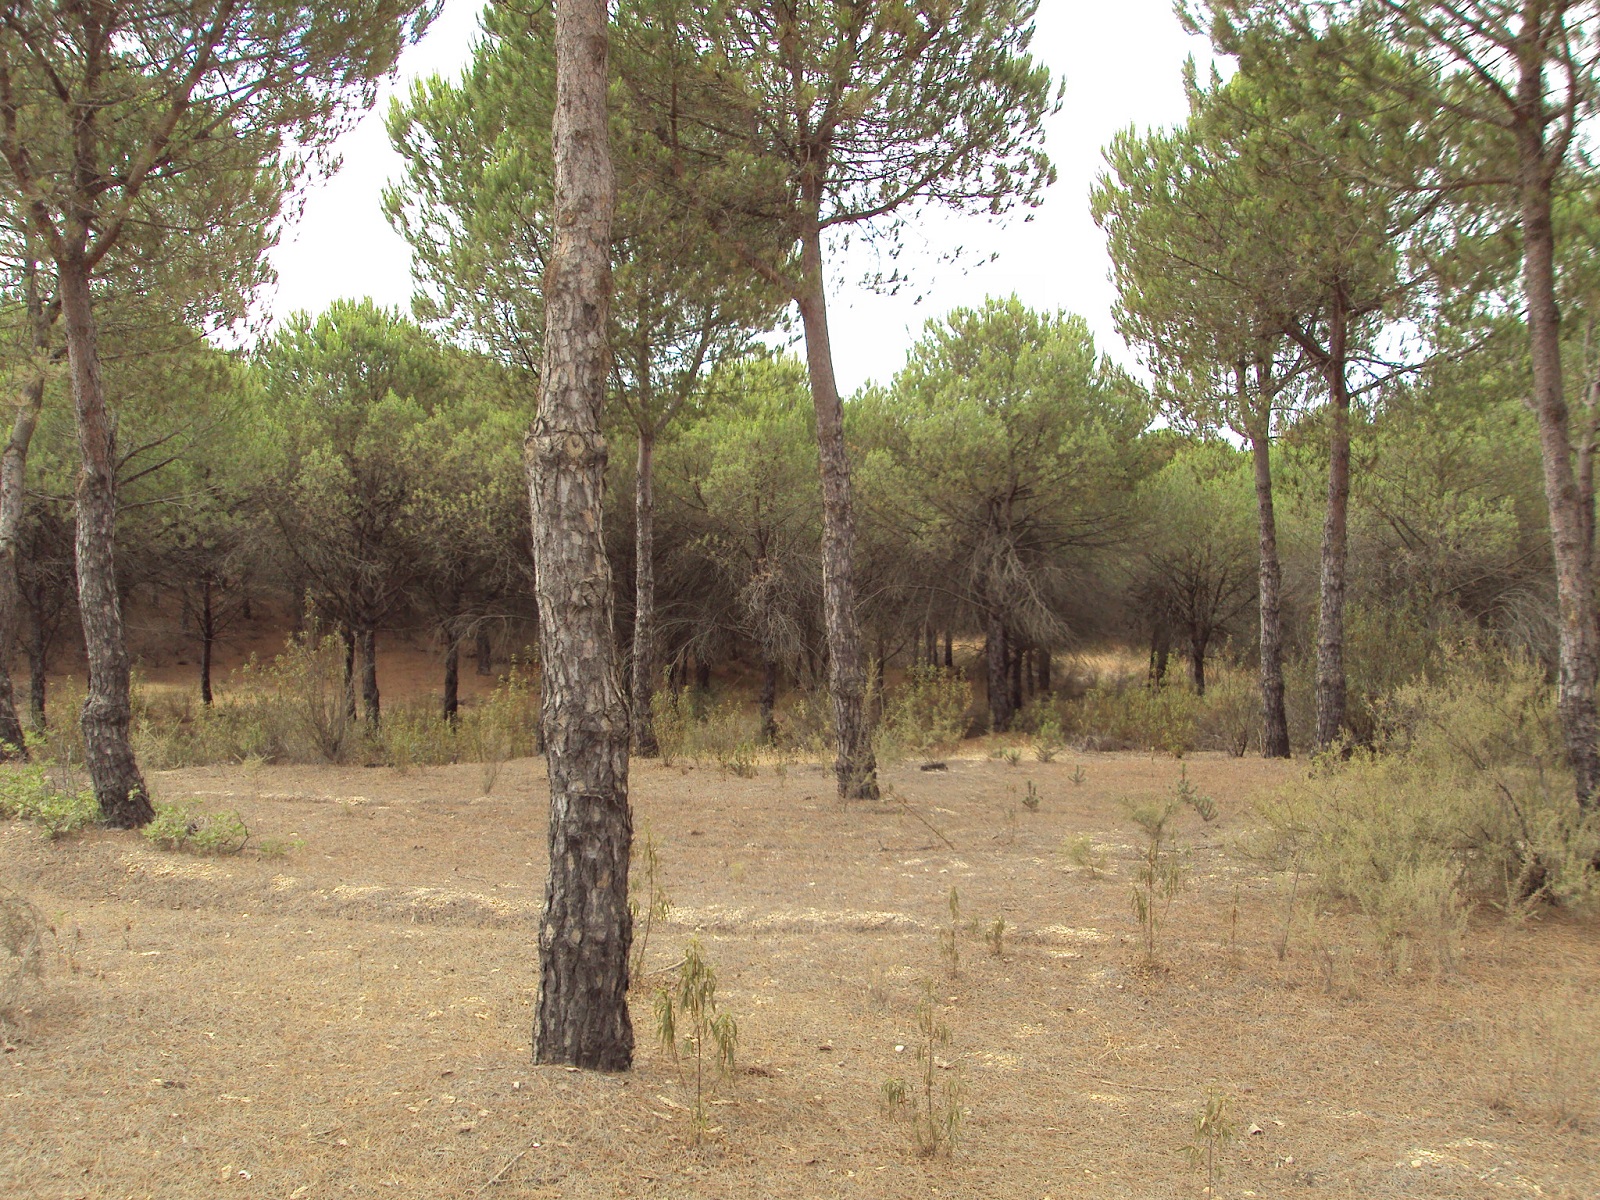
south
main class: Woodland
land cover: Pine dominated coniferous woodland
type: coniferous forest of the mediterranean region
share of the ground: 50 - 75 %
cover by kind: coniferous forest trees 60 %, herbaceous plants 30 %, shrubs 10 %
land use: Forestry
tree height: > 5 m
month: June
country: ES
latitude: 37.2273
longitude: -6.8630
